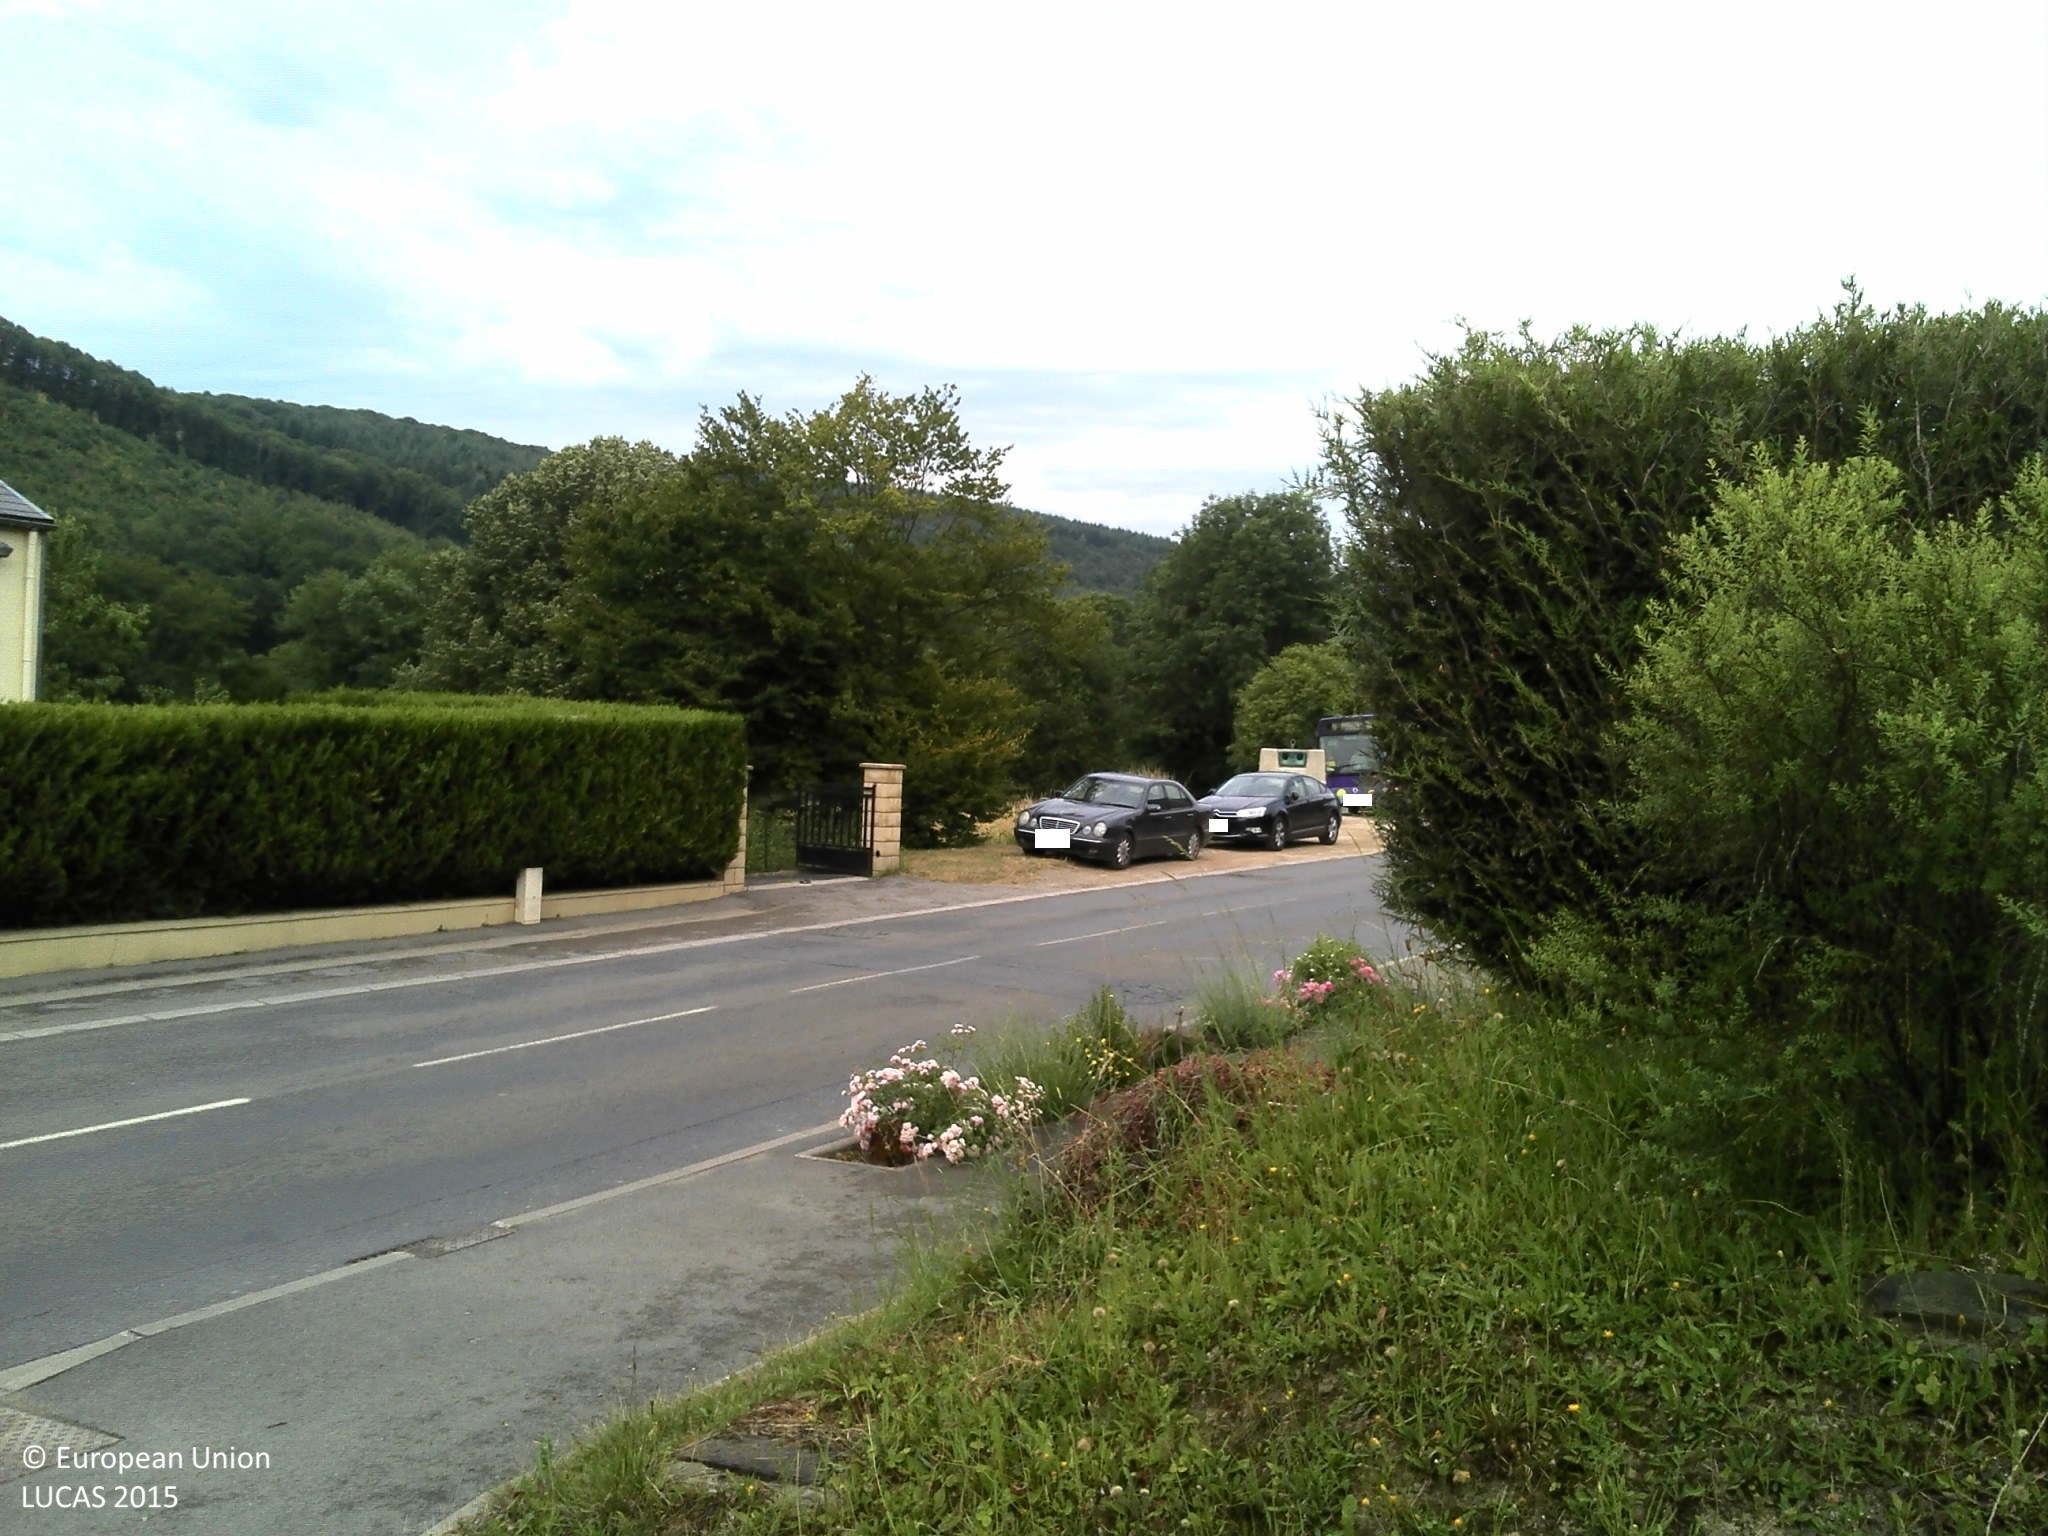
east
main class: Grassland
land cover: Grassland with sparse tree/shrub cover
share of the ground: > 75 %
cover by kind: herbaceous plants 95 %, broadleaved forest trees 5 %
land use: Residential
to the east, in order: Grassland with sparse tree/shrub cover; Artificial constructions in urban areas; Paved roads, cycling and walking lanes; Tracks; Artificial constructions in urban areas; Grassland with sparse tree/shrub cover; Broadleaved woodland; Fences; Grassland without tree/shrub cover
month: July
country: FR
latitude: 49.8127
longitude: 4.7855
